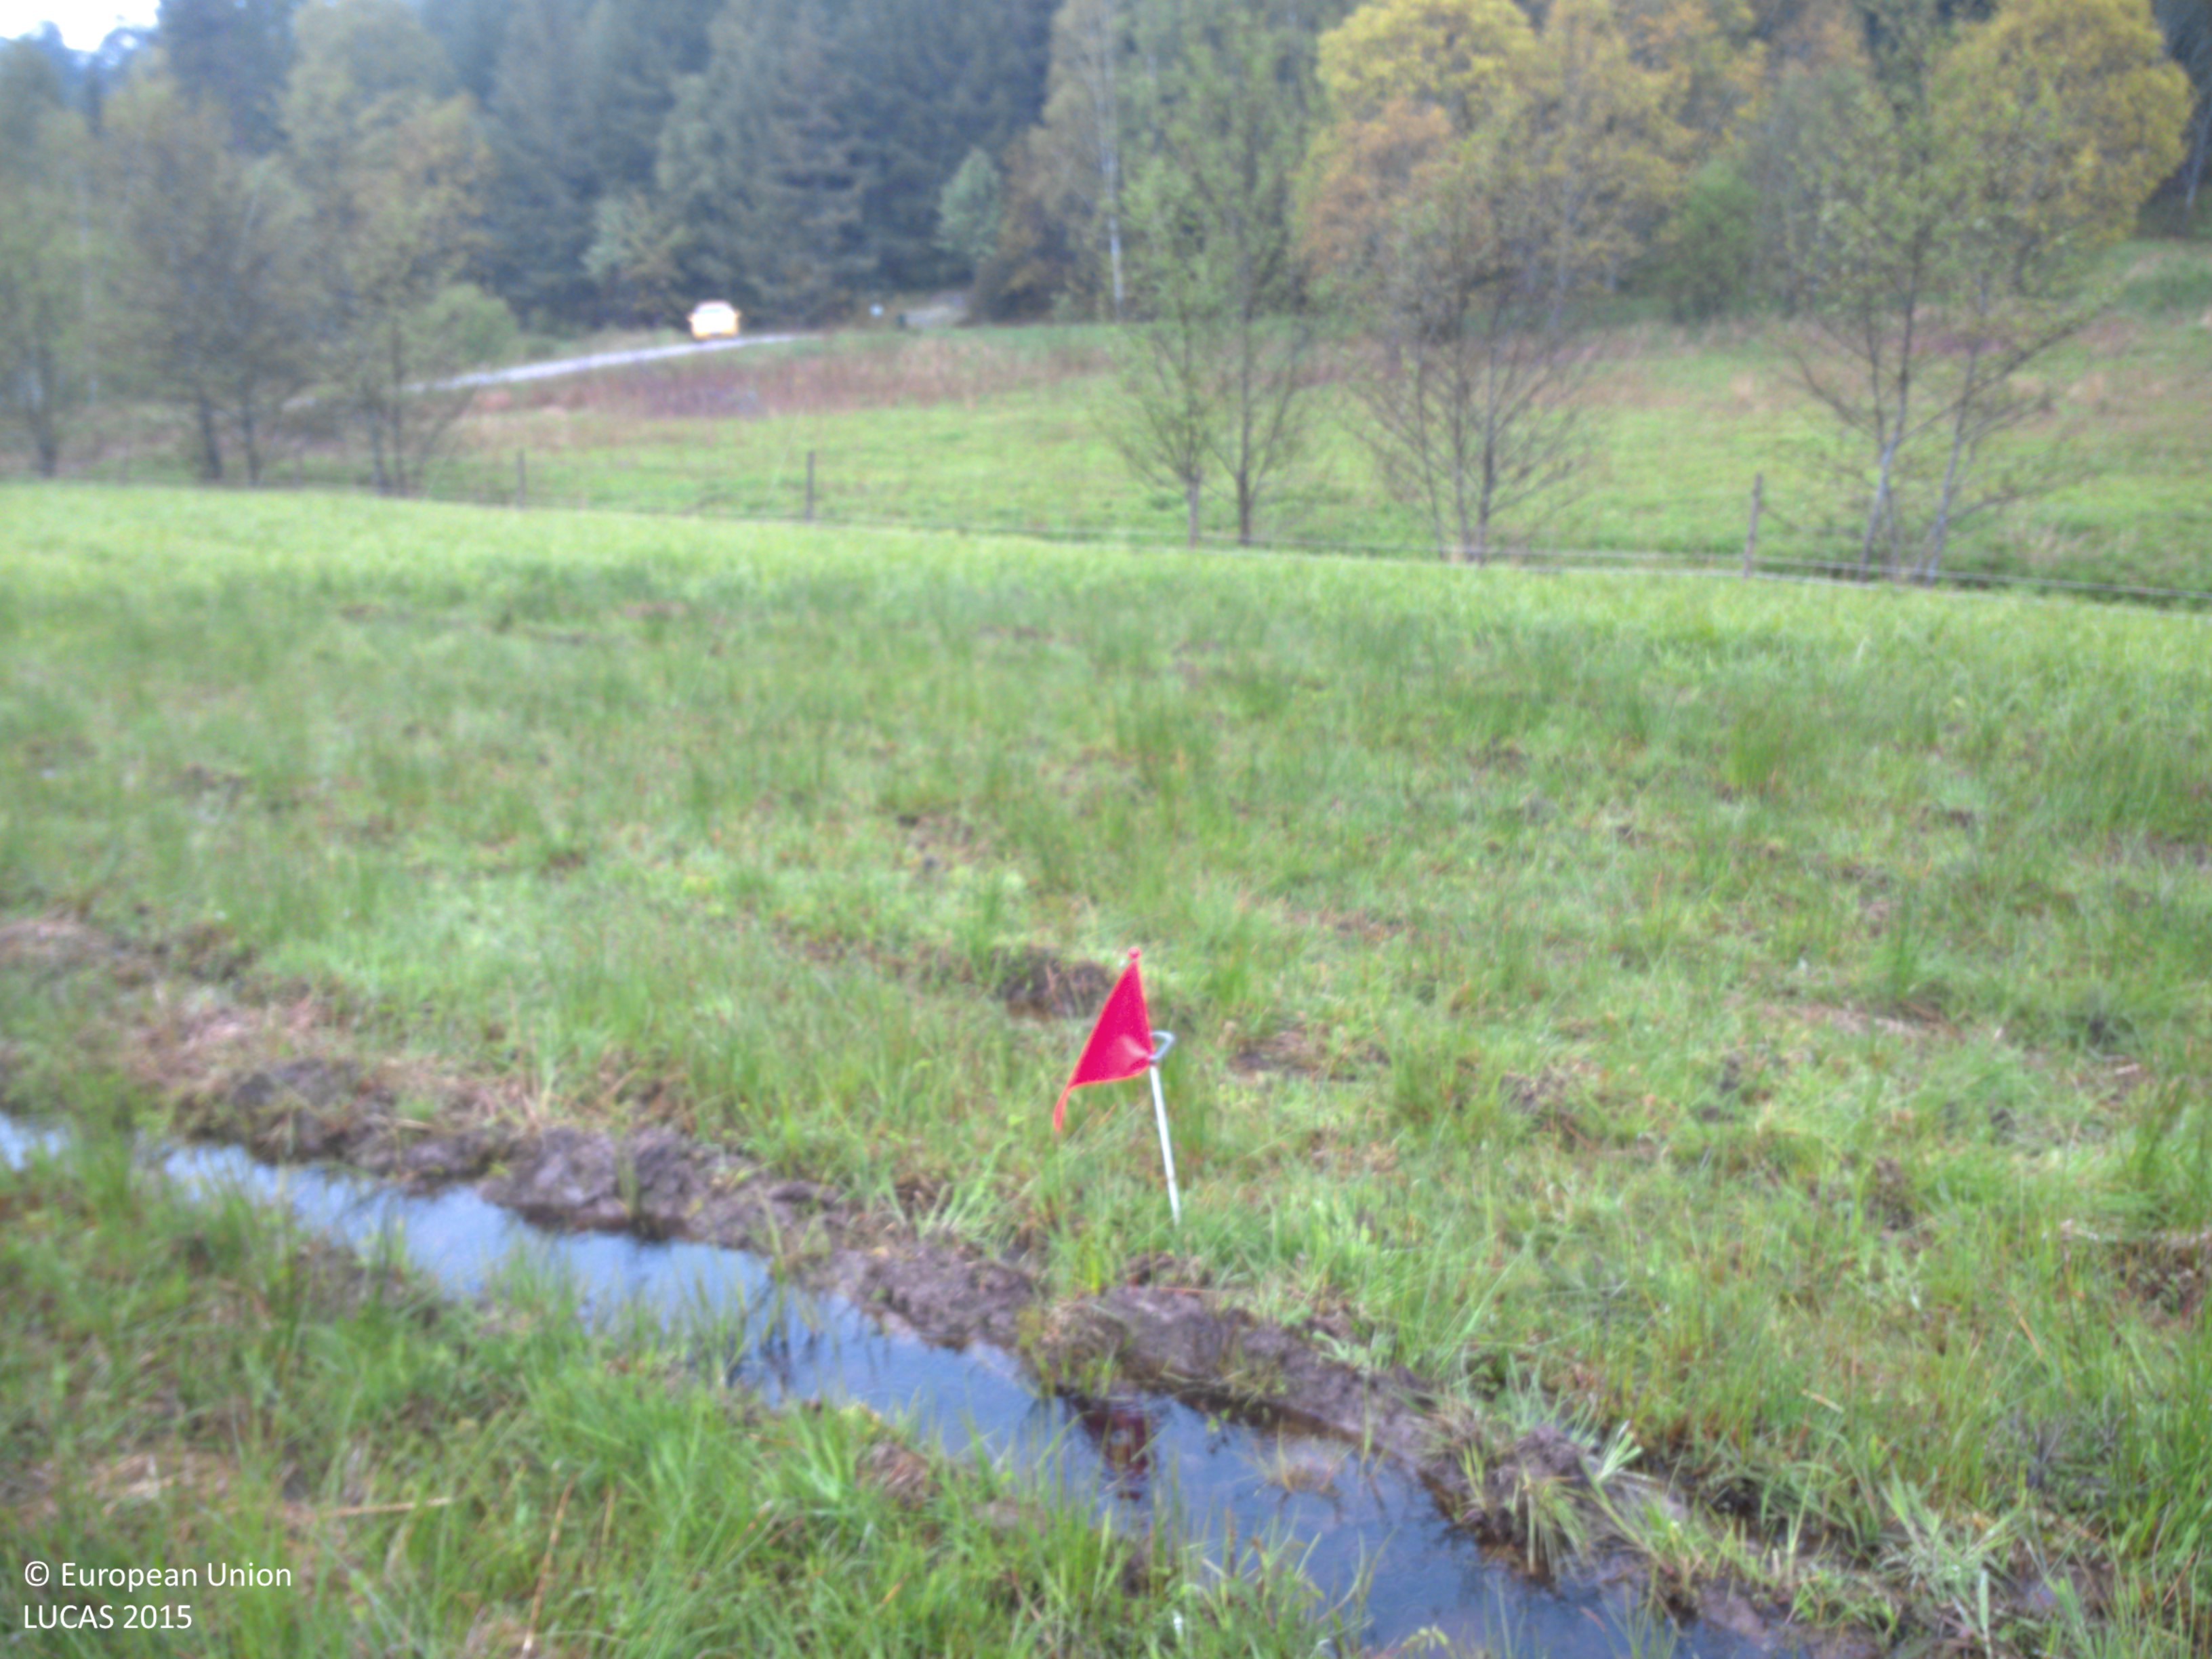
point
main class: Grassland
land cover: Grassland without tree/shrub cover
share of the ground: > 75 %
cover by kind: herbaceous plants 100 %
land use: Agriculture (excluding fallow land and kitchen gardens)
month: May
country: SE
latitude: 58.3708
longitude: 11.6891
